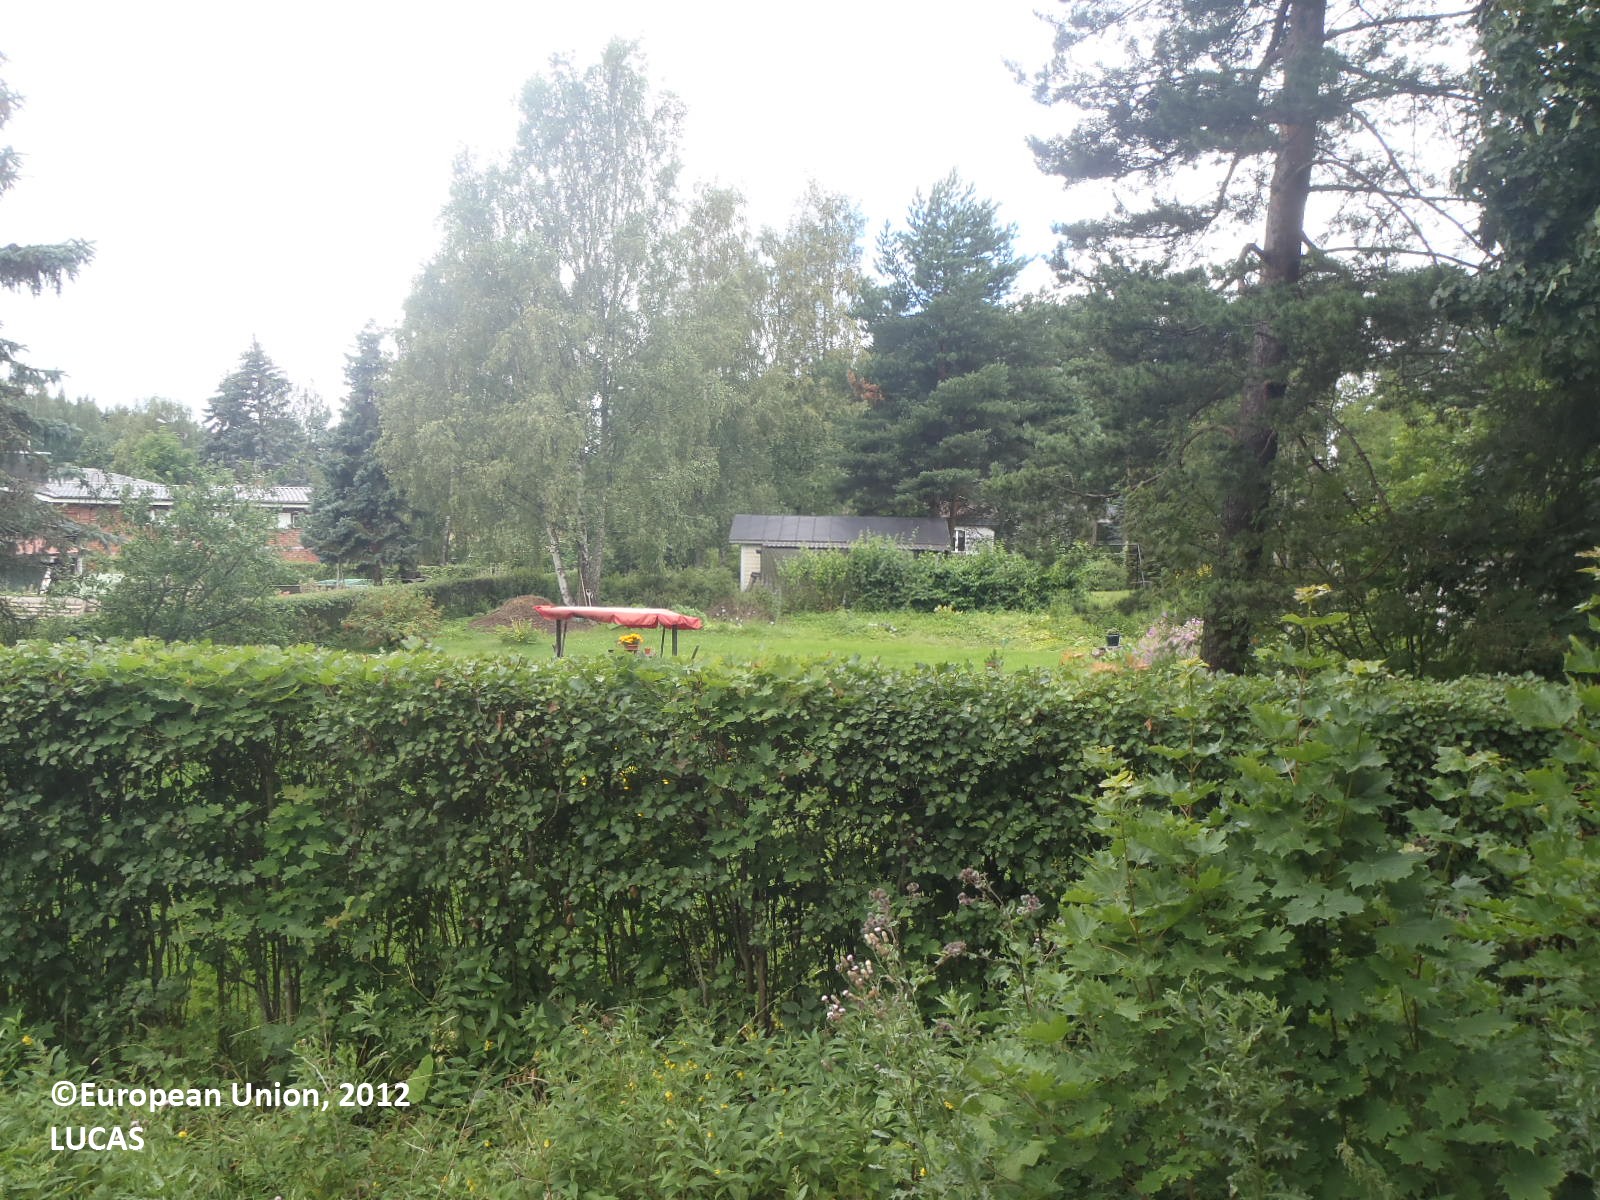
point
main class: Grassland
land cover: Grassland with sparse tree/shrub cover
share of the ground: > 75 %
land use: Residential
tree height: > 5 m
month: July
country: FI
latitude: 60.4671
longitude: 22.2337
